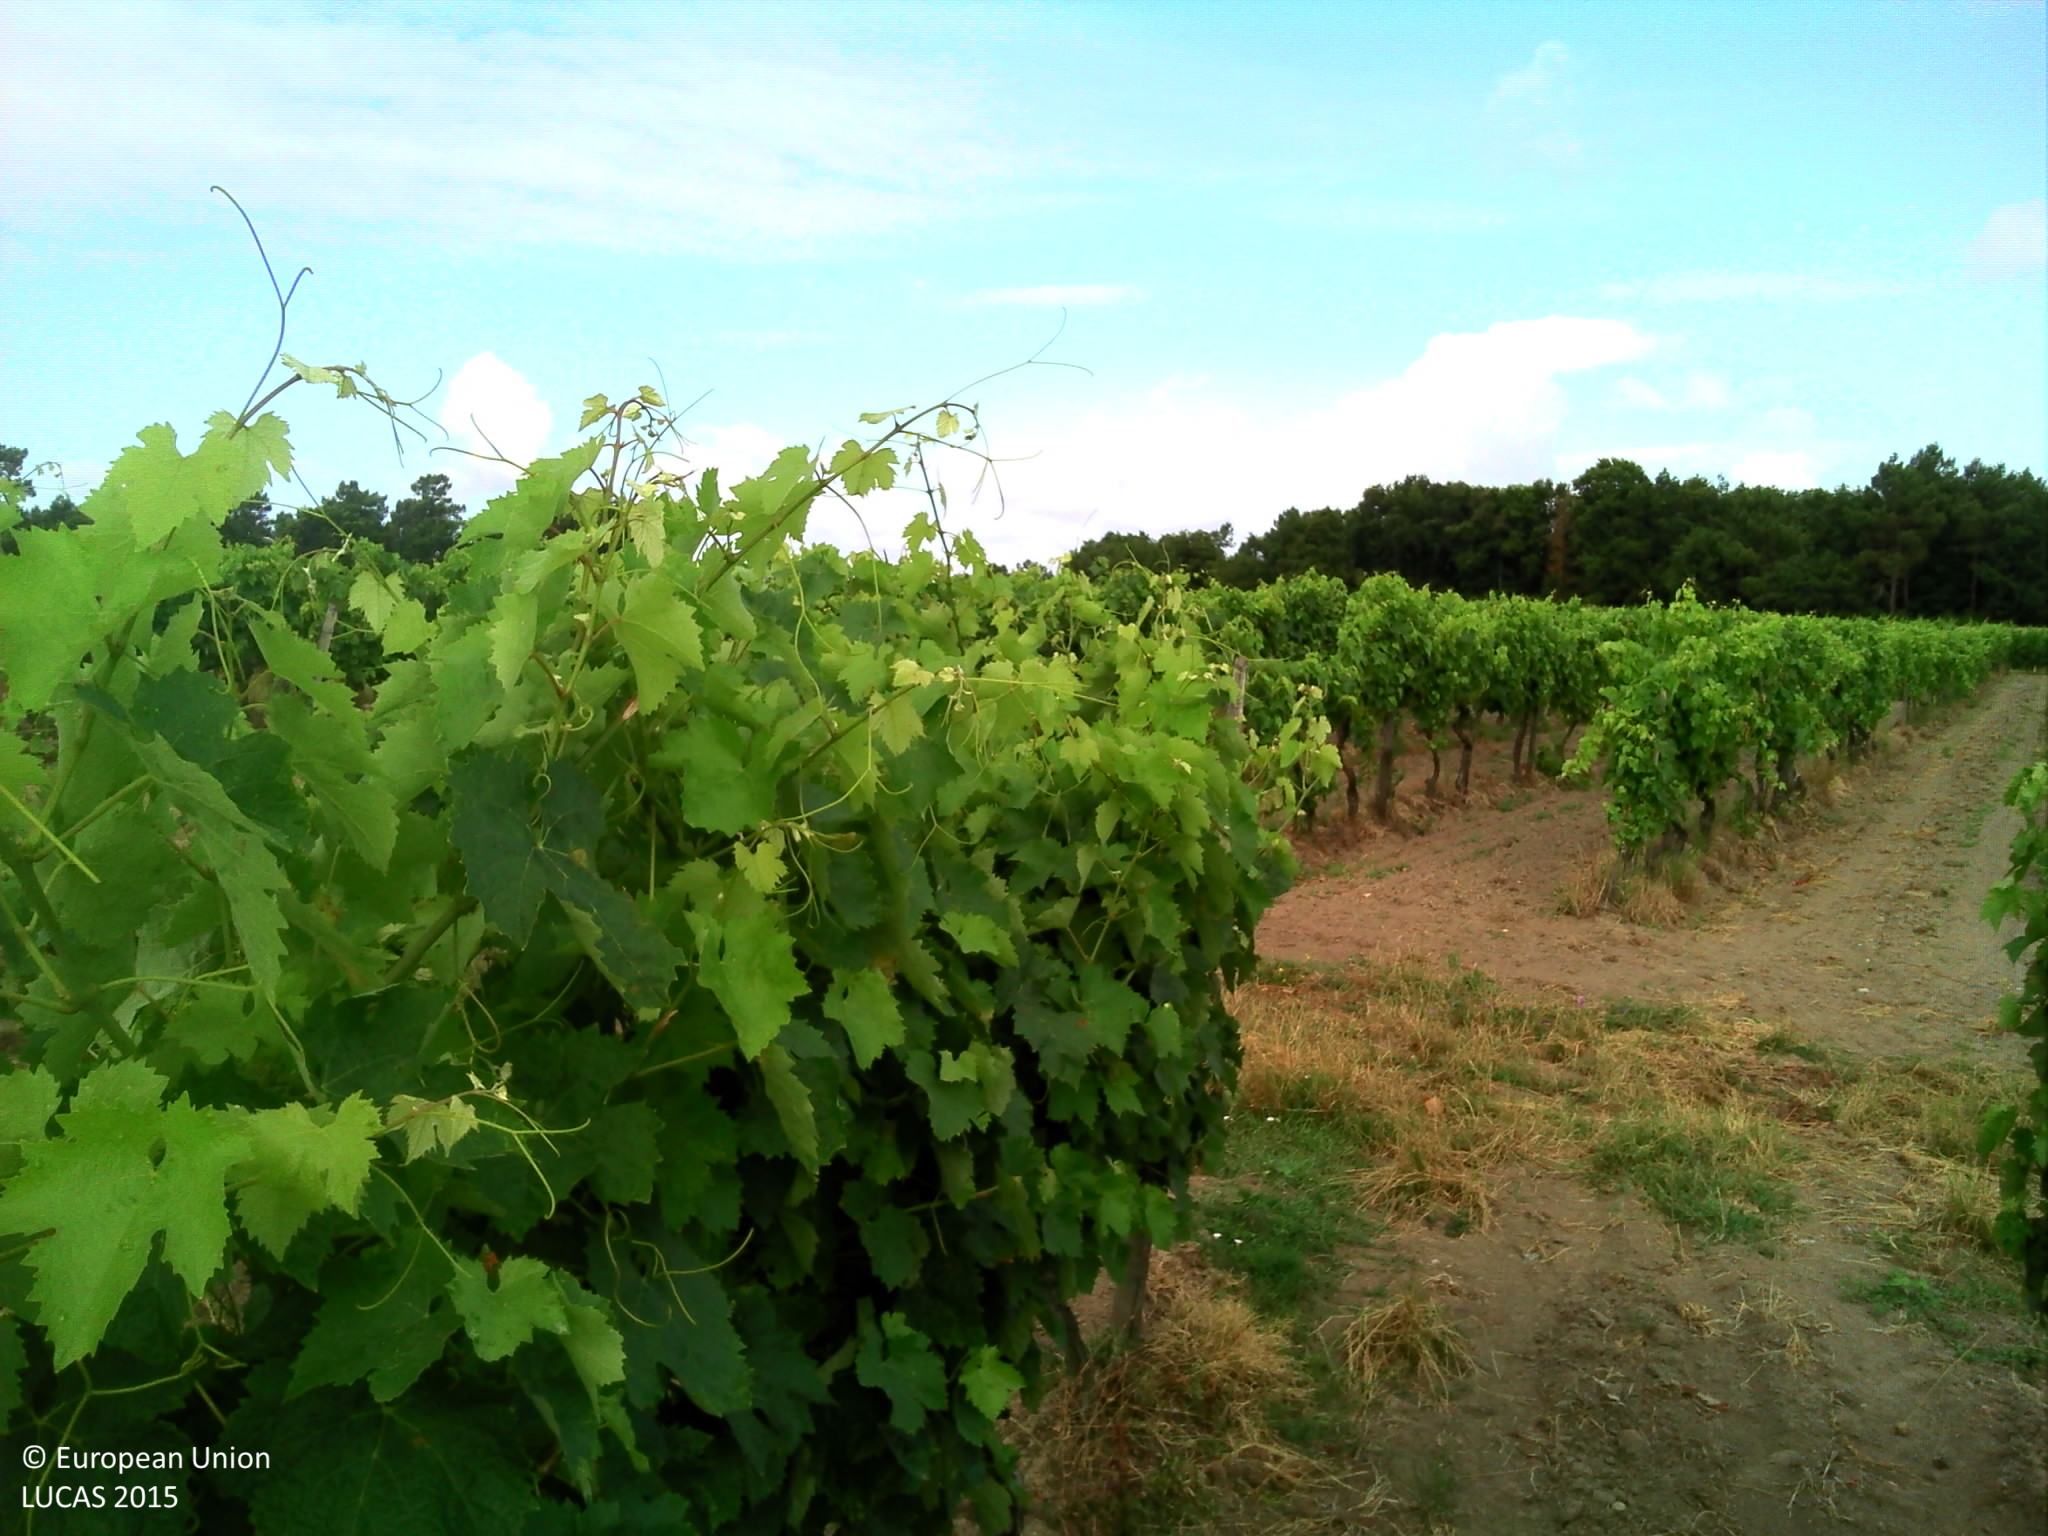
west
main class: Cropland
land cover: Vineyards
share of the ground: 50 - 75 %
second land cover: Other bare soil
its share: > 75 %
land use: Agriculture (excluding fallow land and kitchen gardens)
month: July
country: FR
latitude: 45.3301
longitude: -0.6248
